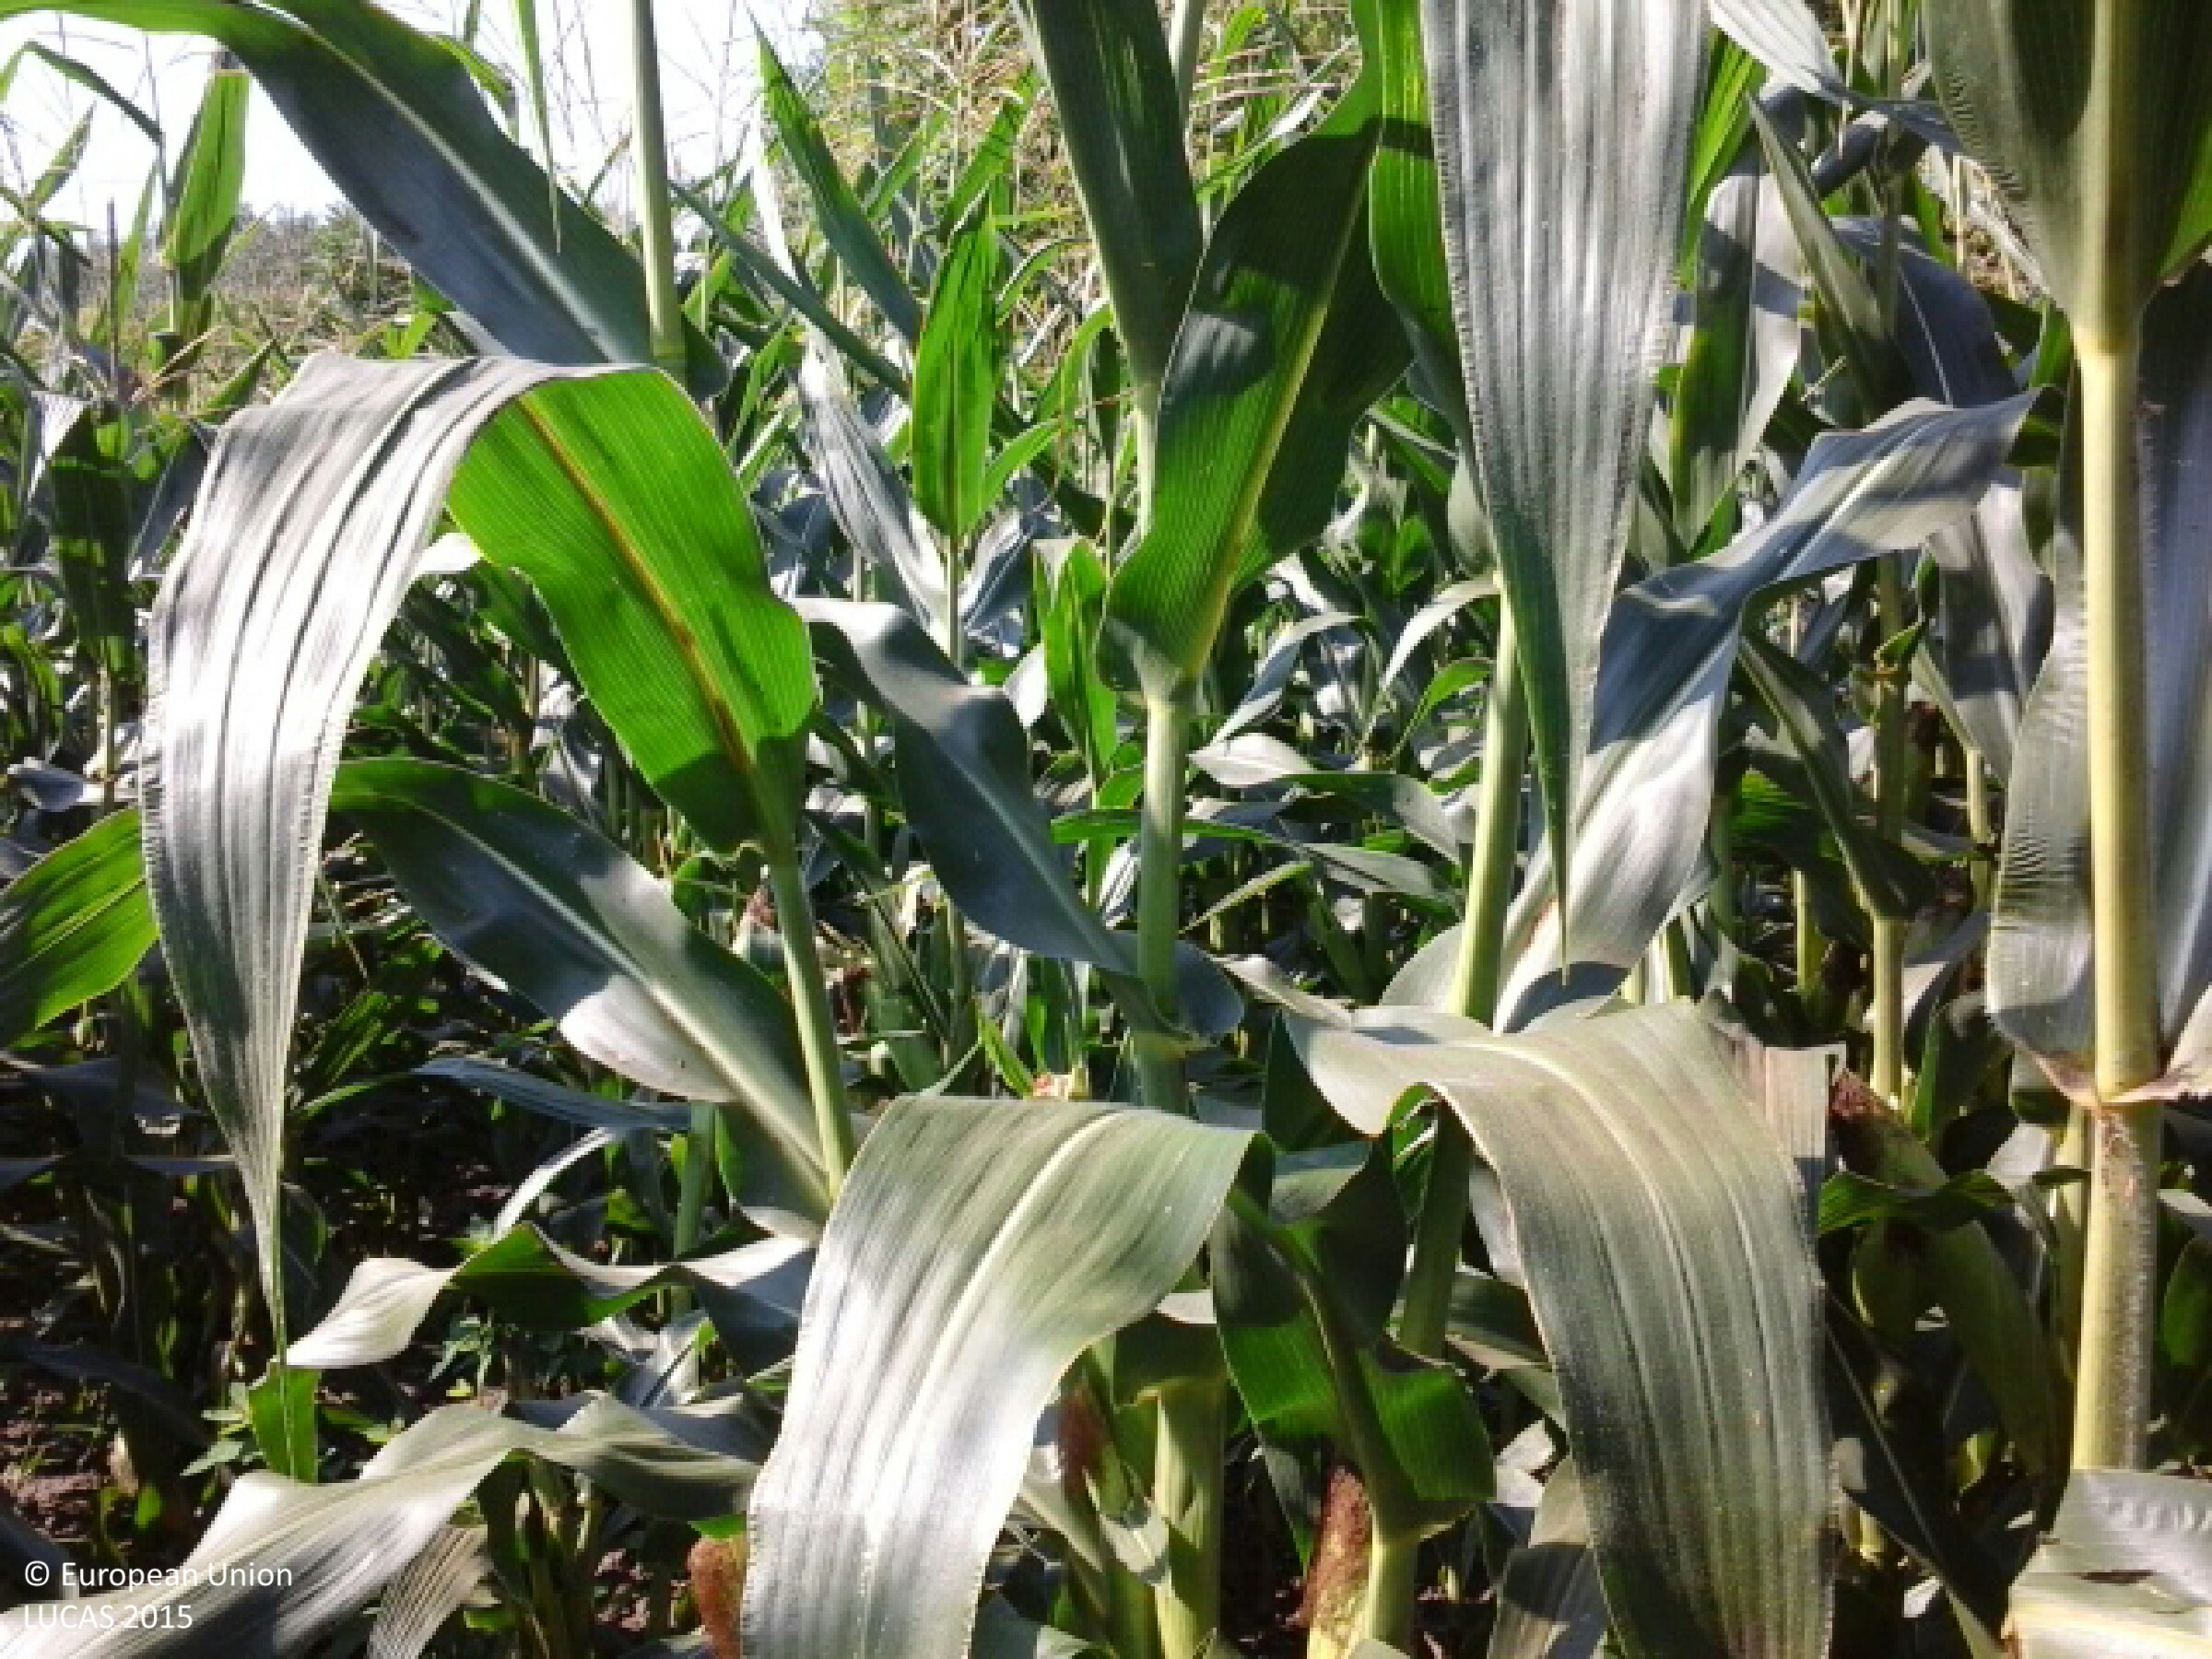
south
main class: Cropland
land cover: Maize
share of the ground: > 75 %
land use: Agriculture (excluding fallow land and kitchen gardens)
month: August
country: HU
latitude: 47.5549
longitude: 17.9709
